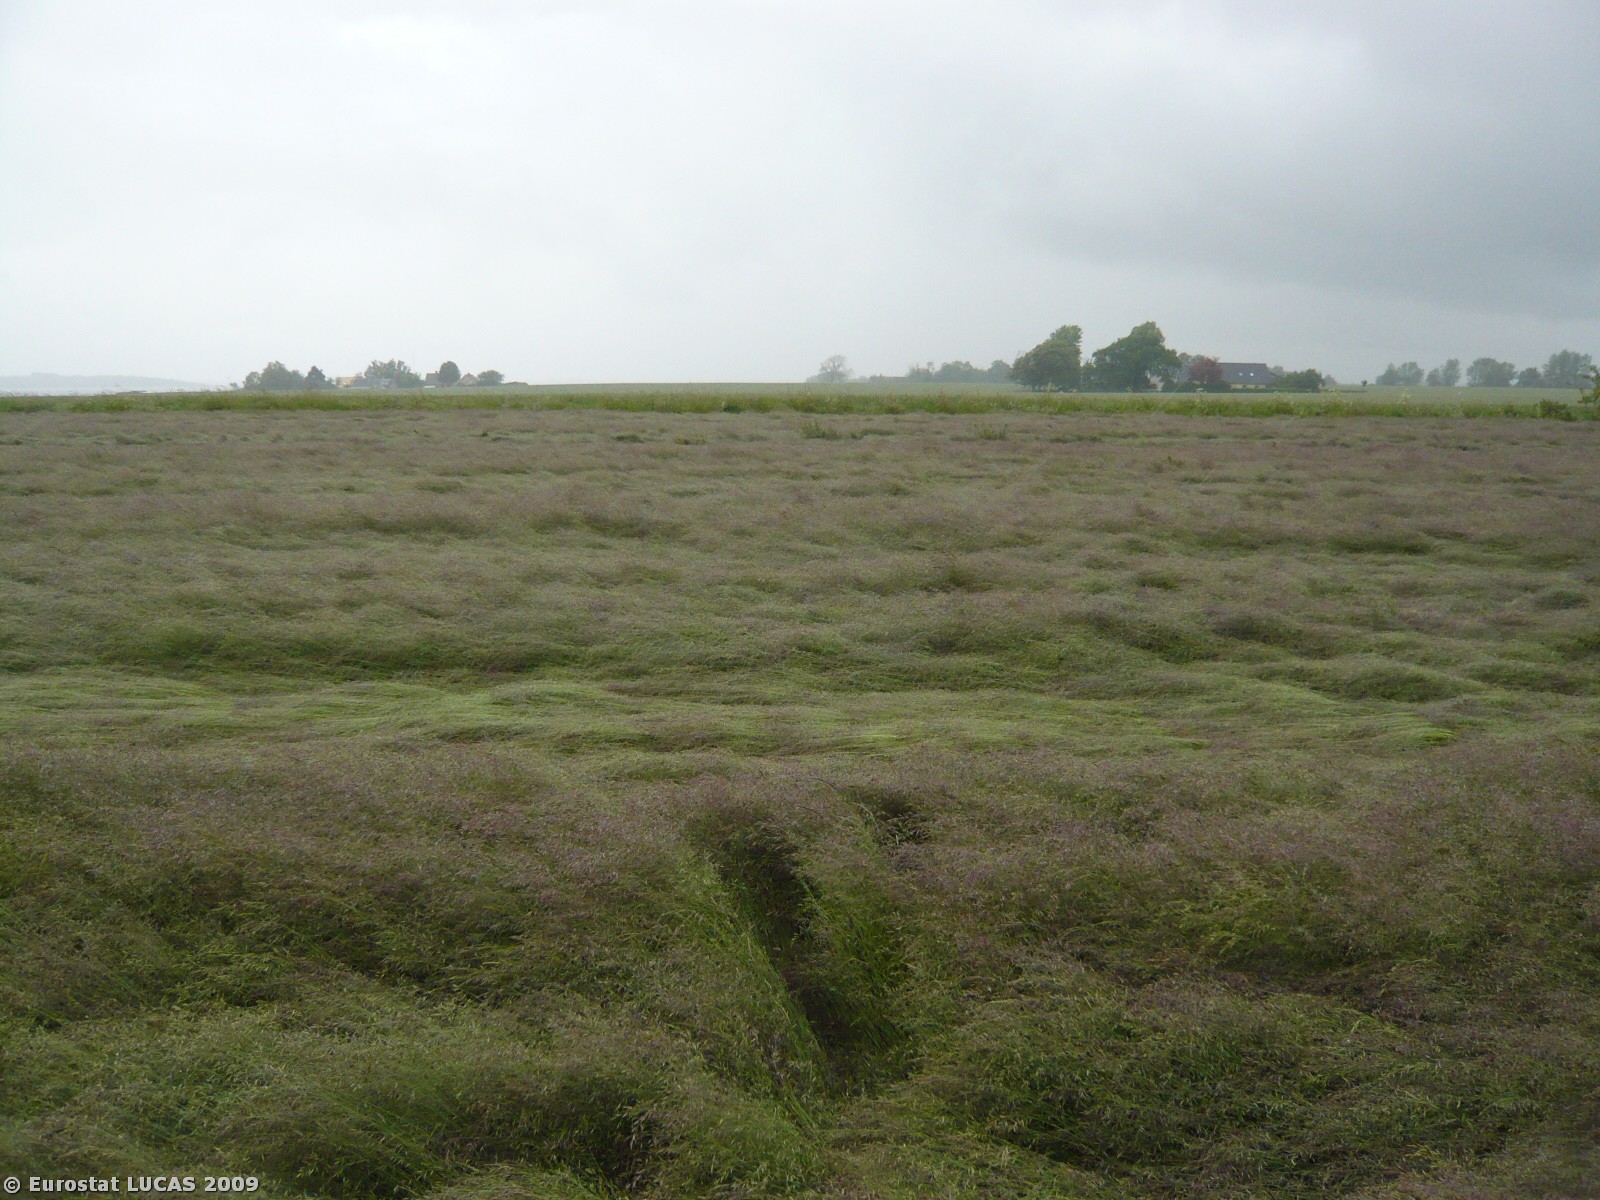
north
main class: Cropland
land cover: Temporary grasslands
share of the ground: > 75 %
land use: Agriculture (excluding fallow land and kitchen gardens)
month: June
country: DK
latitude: 54.6638
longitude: 11.8748
